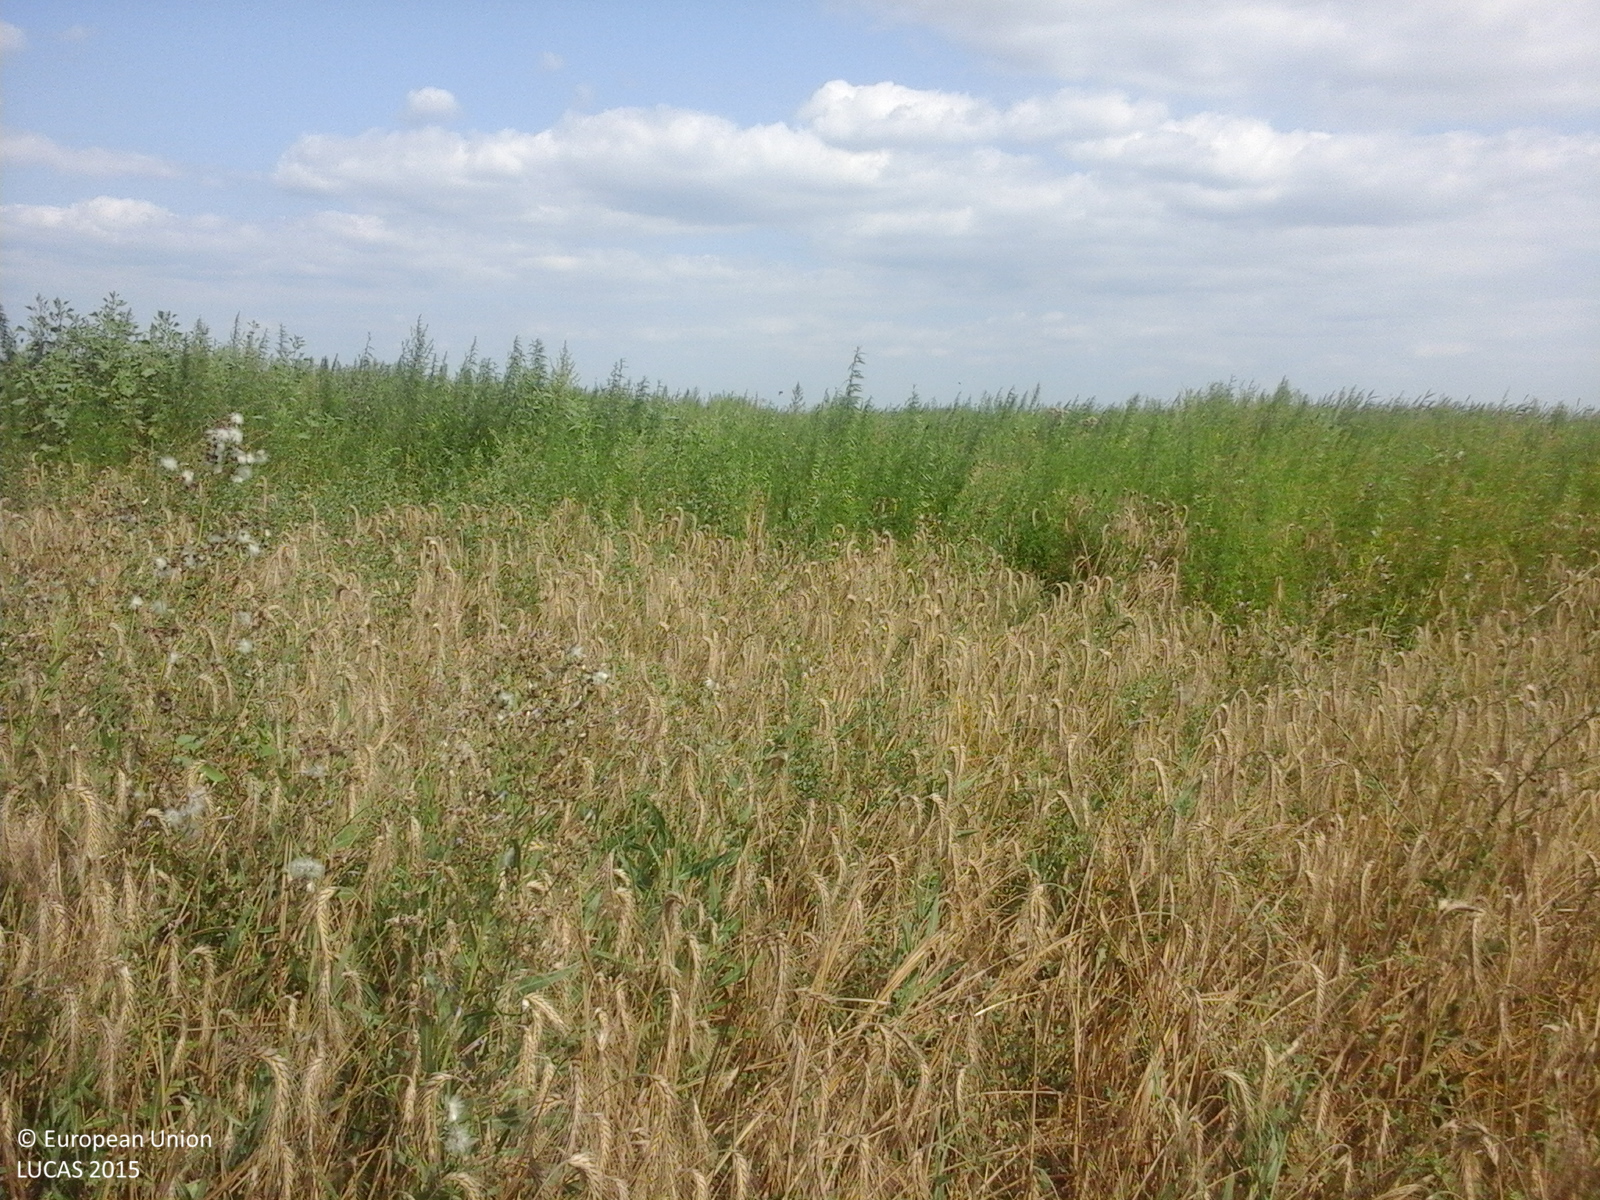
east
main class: Cropland
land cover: Barley
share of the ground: > 75 %
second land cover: Spontaneously vegetated surfaces
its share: > 75 %
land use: Agriculture (excluding fallow land and kitchen gardens)
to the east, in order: Barley; Spontaneously vegetated surfaces
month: August
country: RO
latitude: 45.2815
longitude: 29.1626
